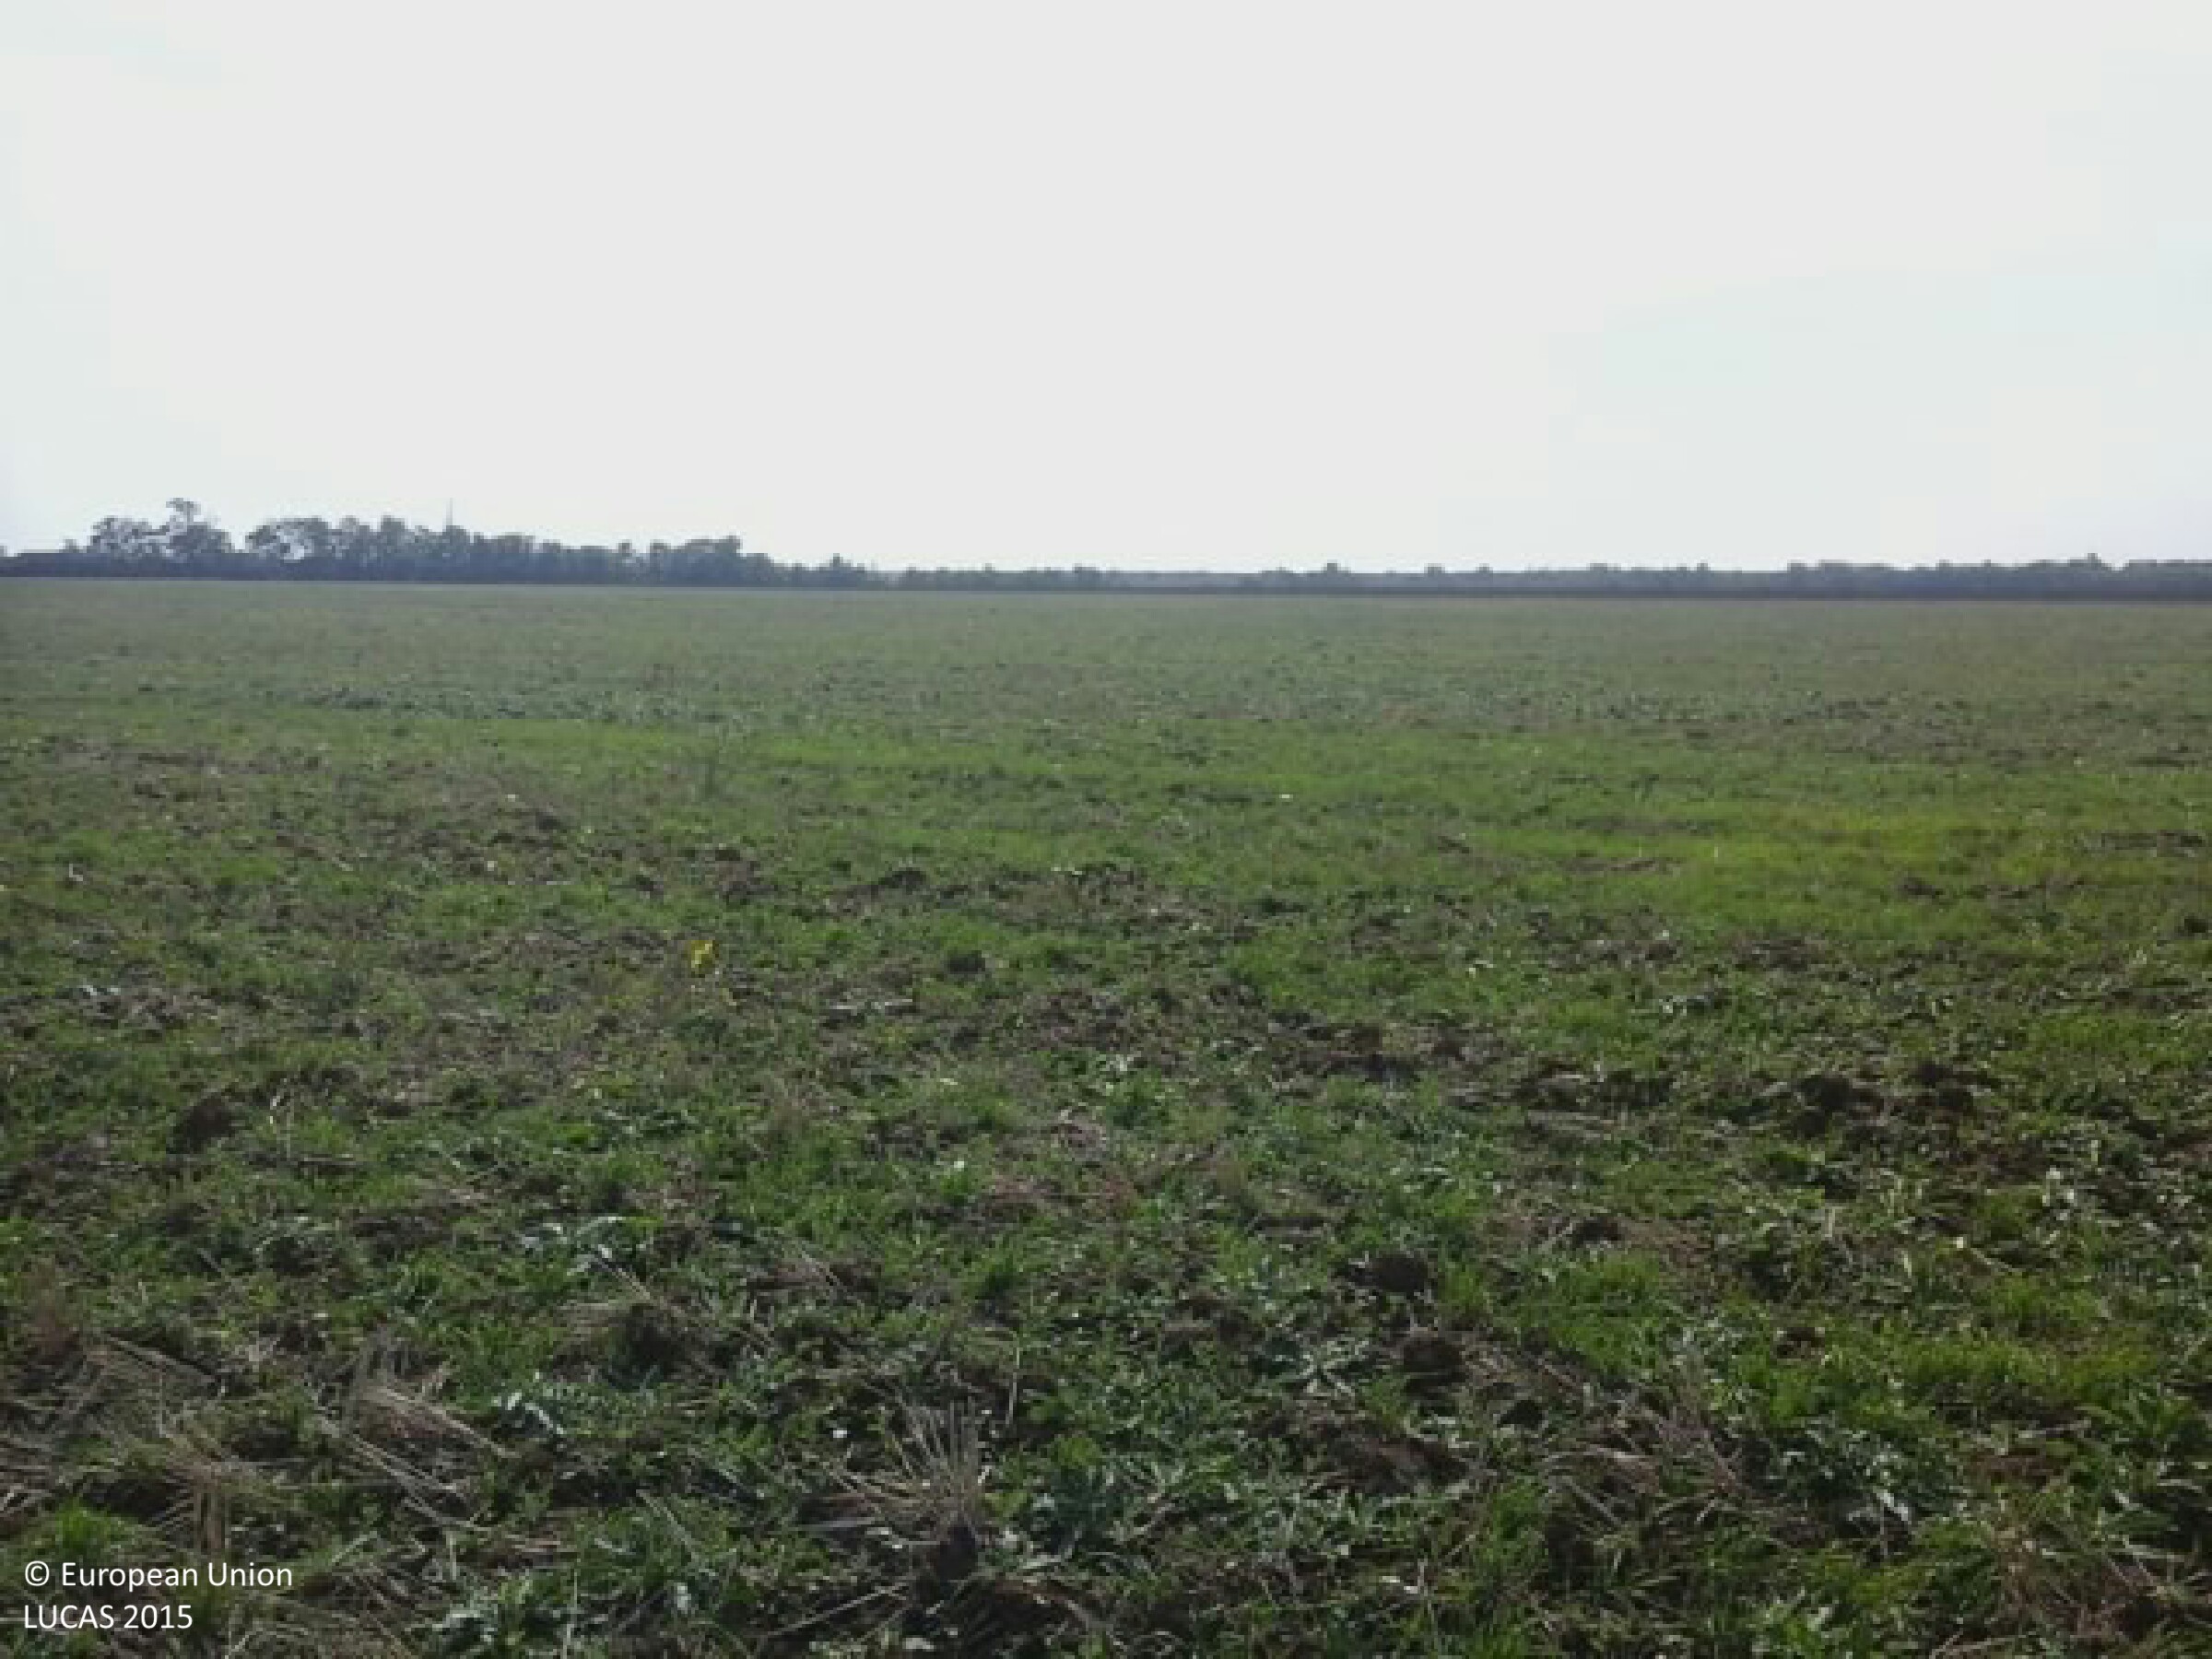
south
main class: Grassland
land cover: Spontaneously vegetated surfaces
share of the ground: > 75 %
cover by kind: herbaceous plants 95 %, unconsolidated bare surface 5 %
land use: Agriculture (excluding fallow land and kitchen gardens)
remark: Harvested field
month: September
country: HU
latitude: 47.7245
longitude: 19.8781
